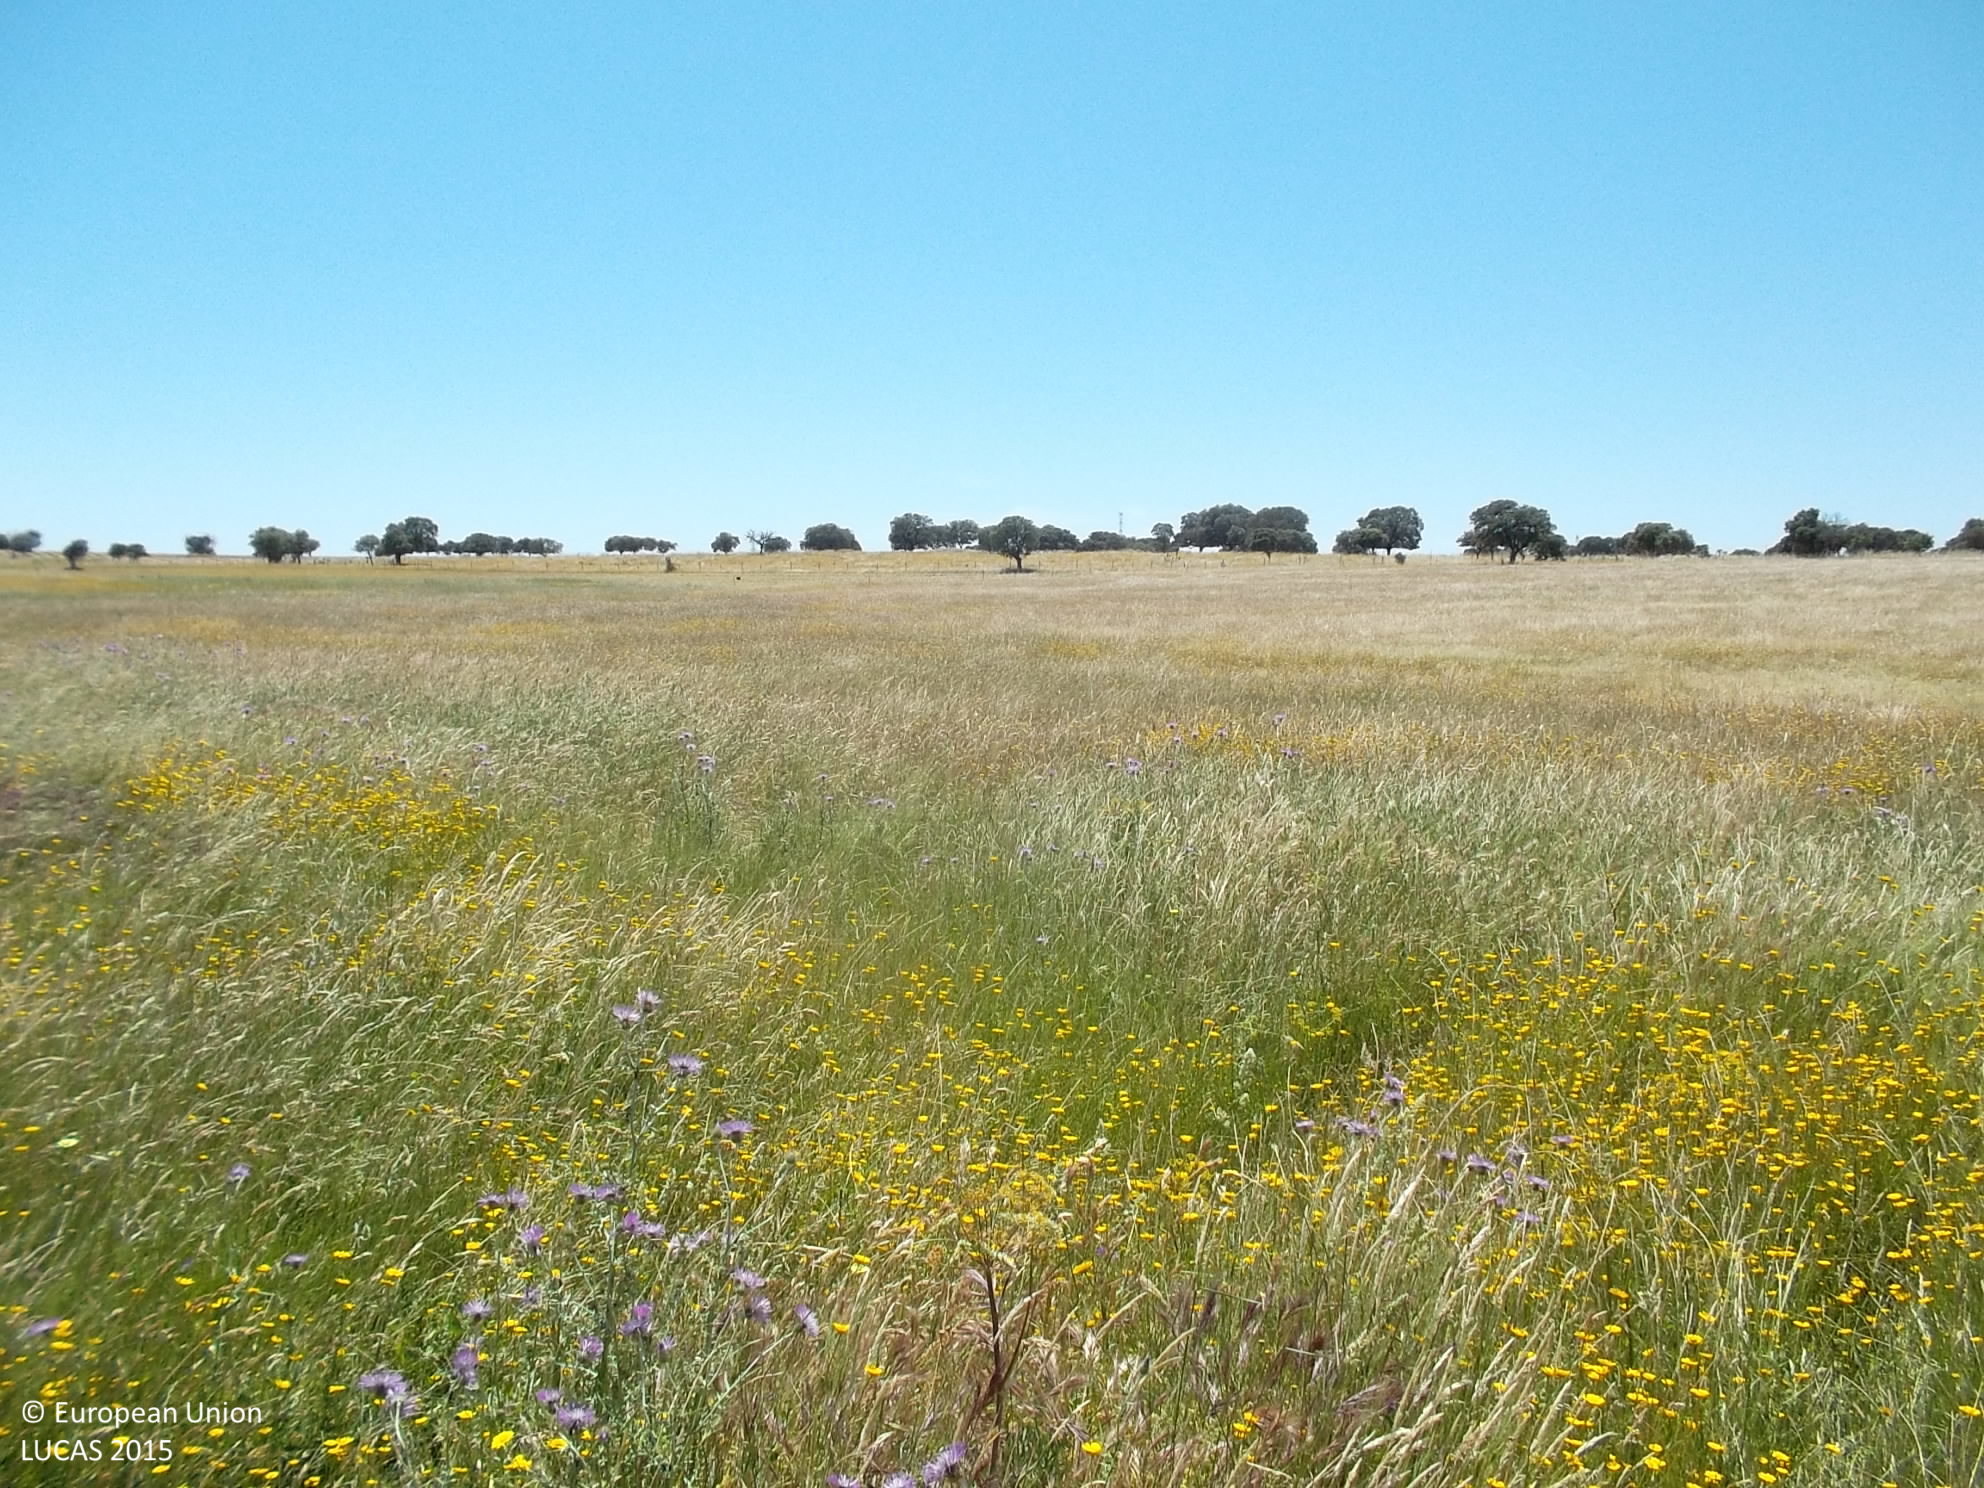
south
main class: Grassland
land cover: Grassland with sparse tree/shrub cover
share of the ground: > 75 %
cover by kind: herbaceous plants 95 %, broadleaved forest trees 5 %
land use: Agriculture (excluding fallow land and kitchen gardens)
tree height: > 5 m
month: May
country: ES
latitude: 38.8976
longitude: -4.4502
